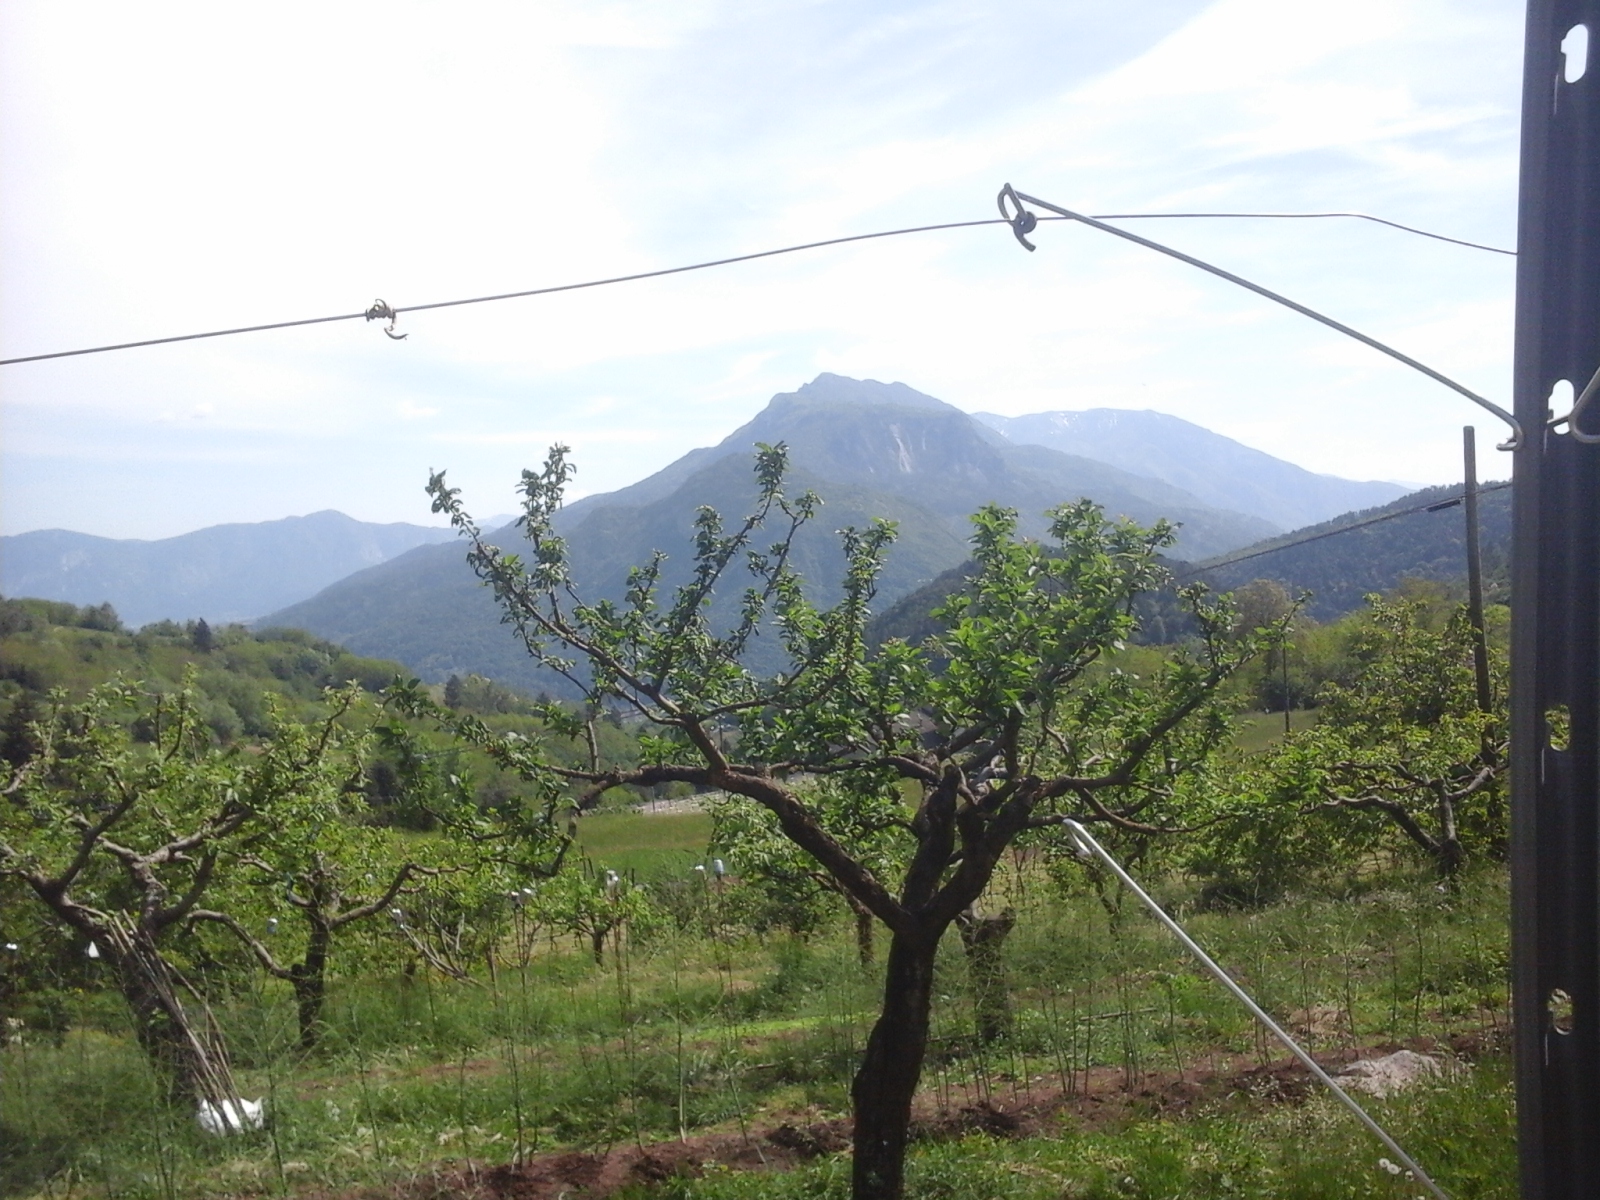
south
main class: Cropland
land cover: Vineyards
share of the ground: < 10 %
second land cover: Grassland without tree/shrub cover
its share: > 75 %
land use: Agriculture (excluding fallow land and kitchen gardens)
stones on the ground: < 10 %
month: May
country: IT
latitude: 46.1105
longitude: 11.1757
